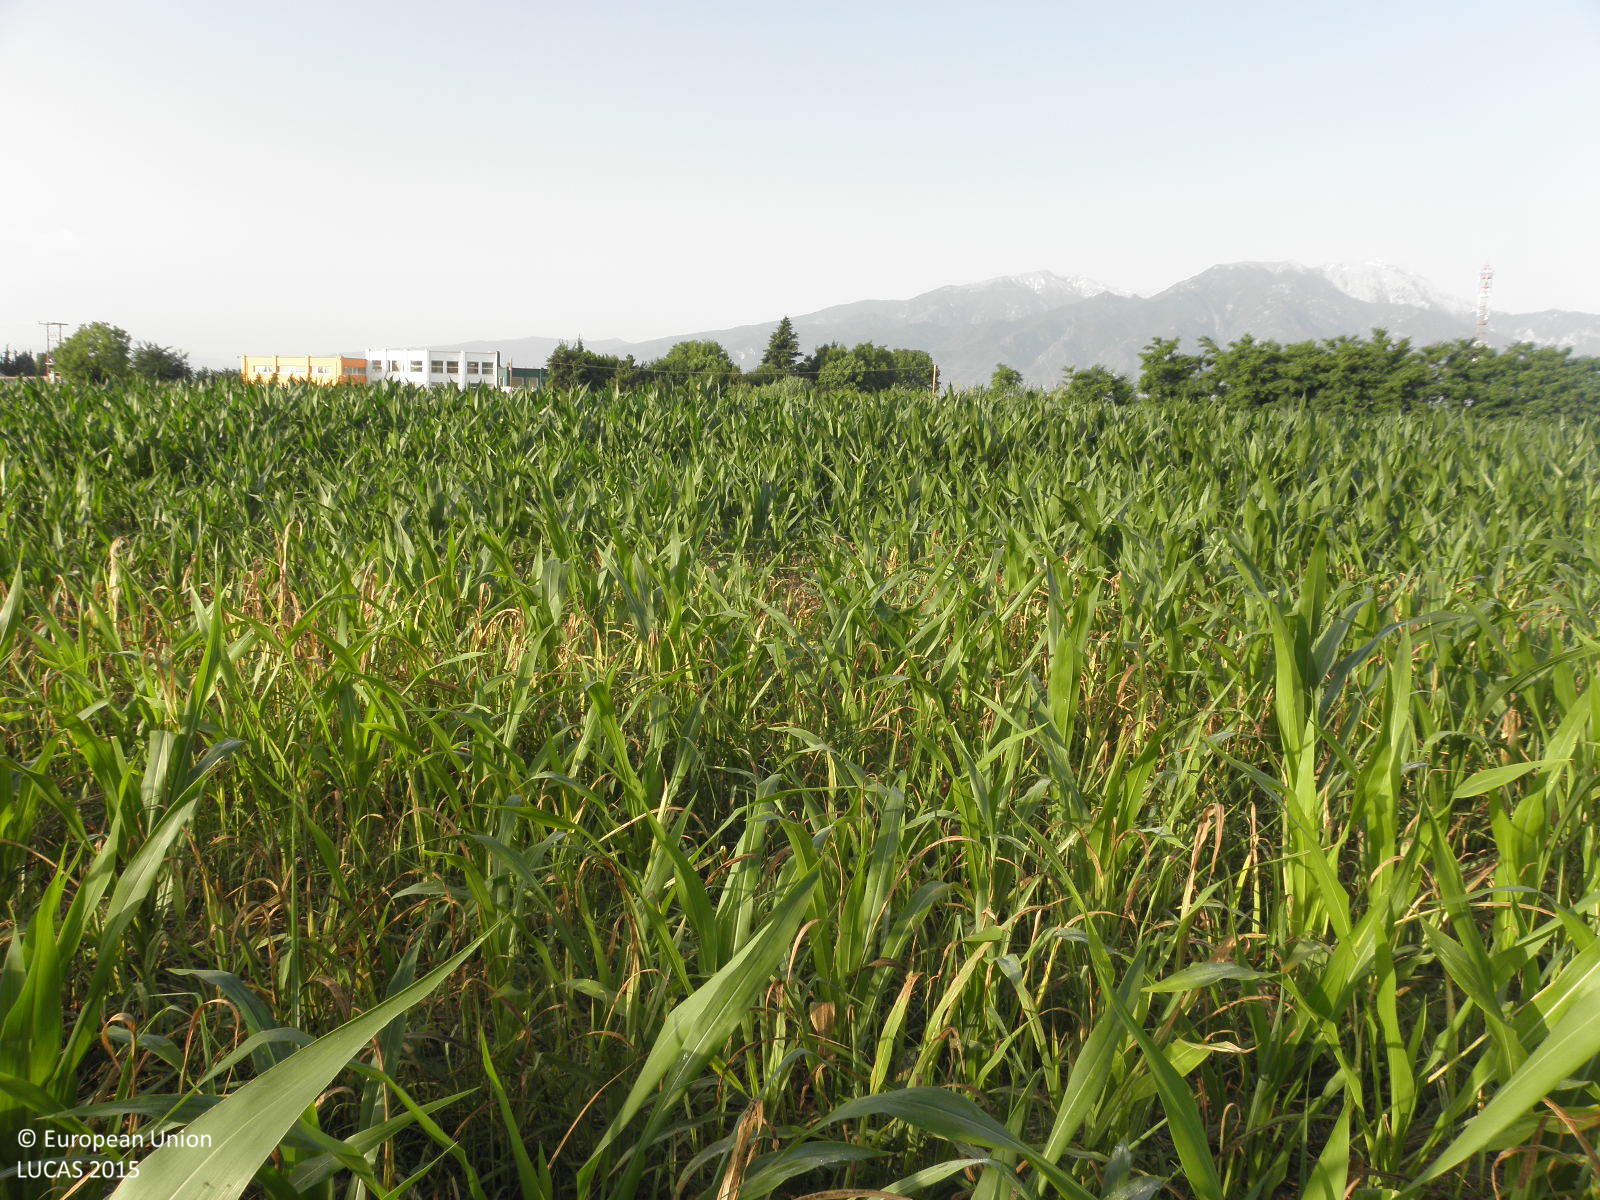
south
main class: Cropland
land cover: Maize
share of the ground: > 75 %
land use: Agriculture (excluding fallow land and kitchen gardens)
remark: Tilled/Sowed
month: June
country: GR
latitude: 40.2484
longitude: 22.5181
